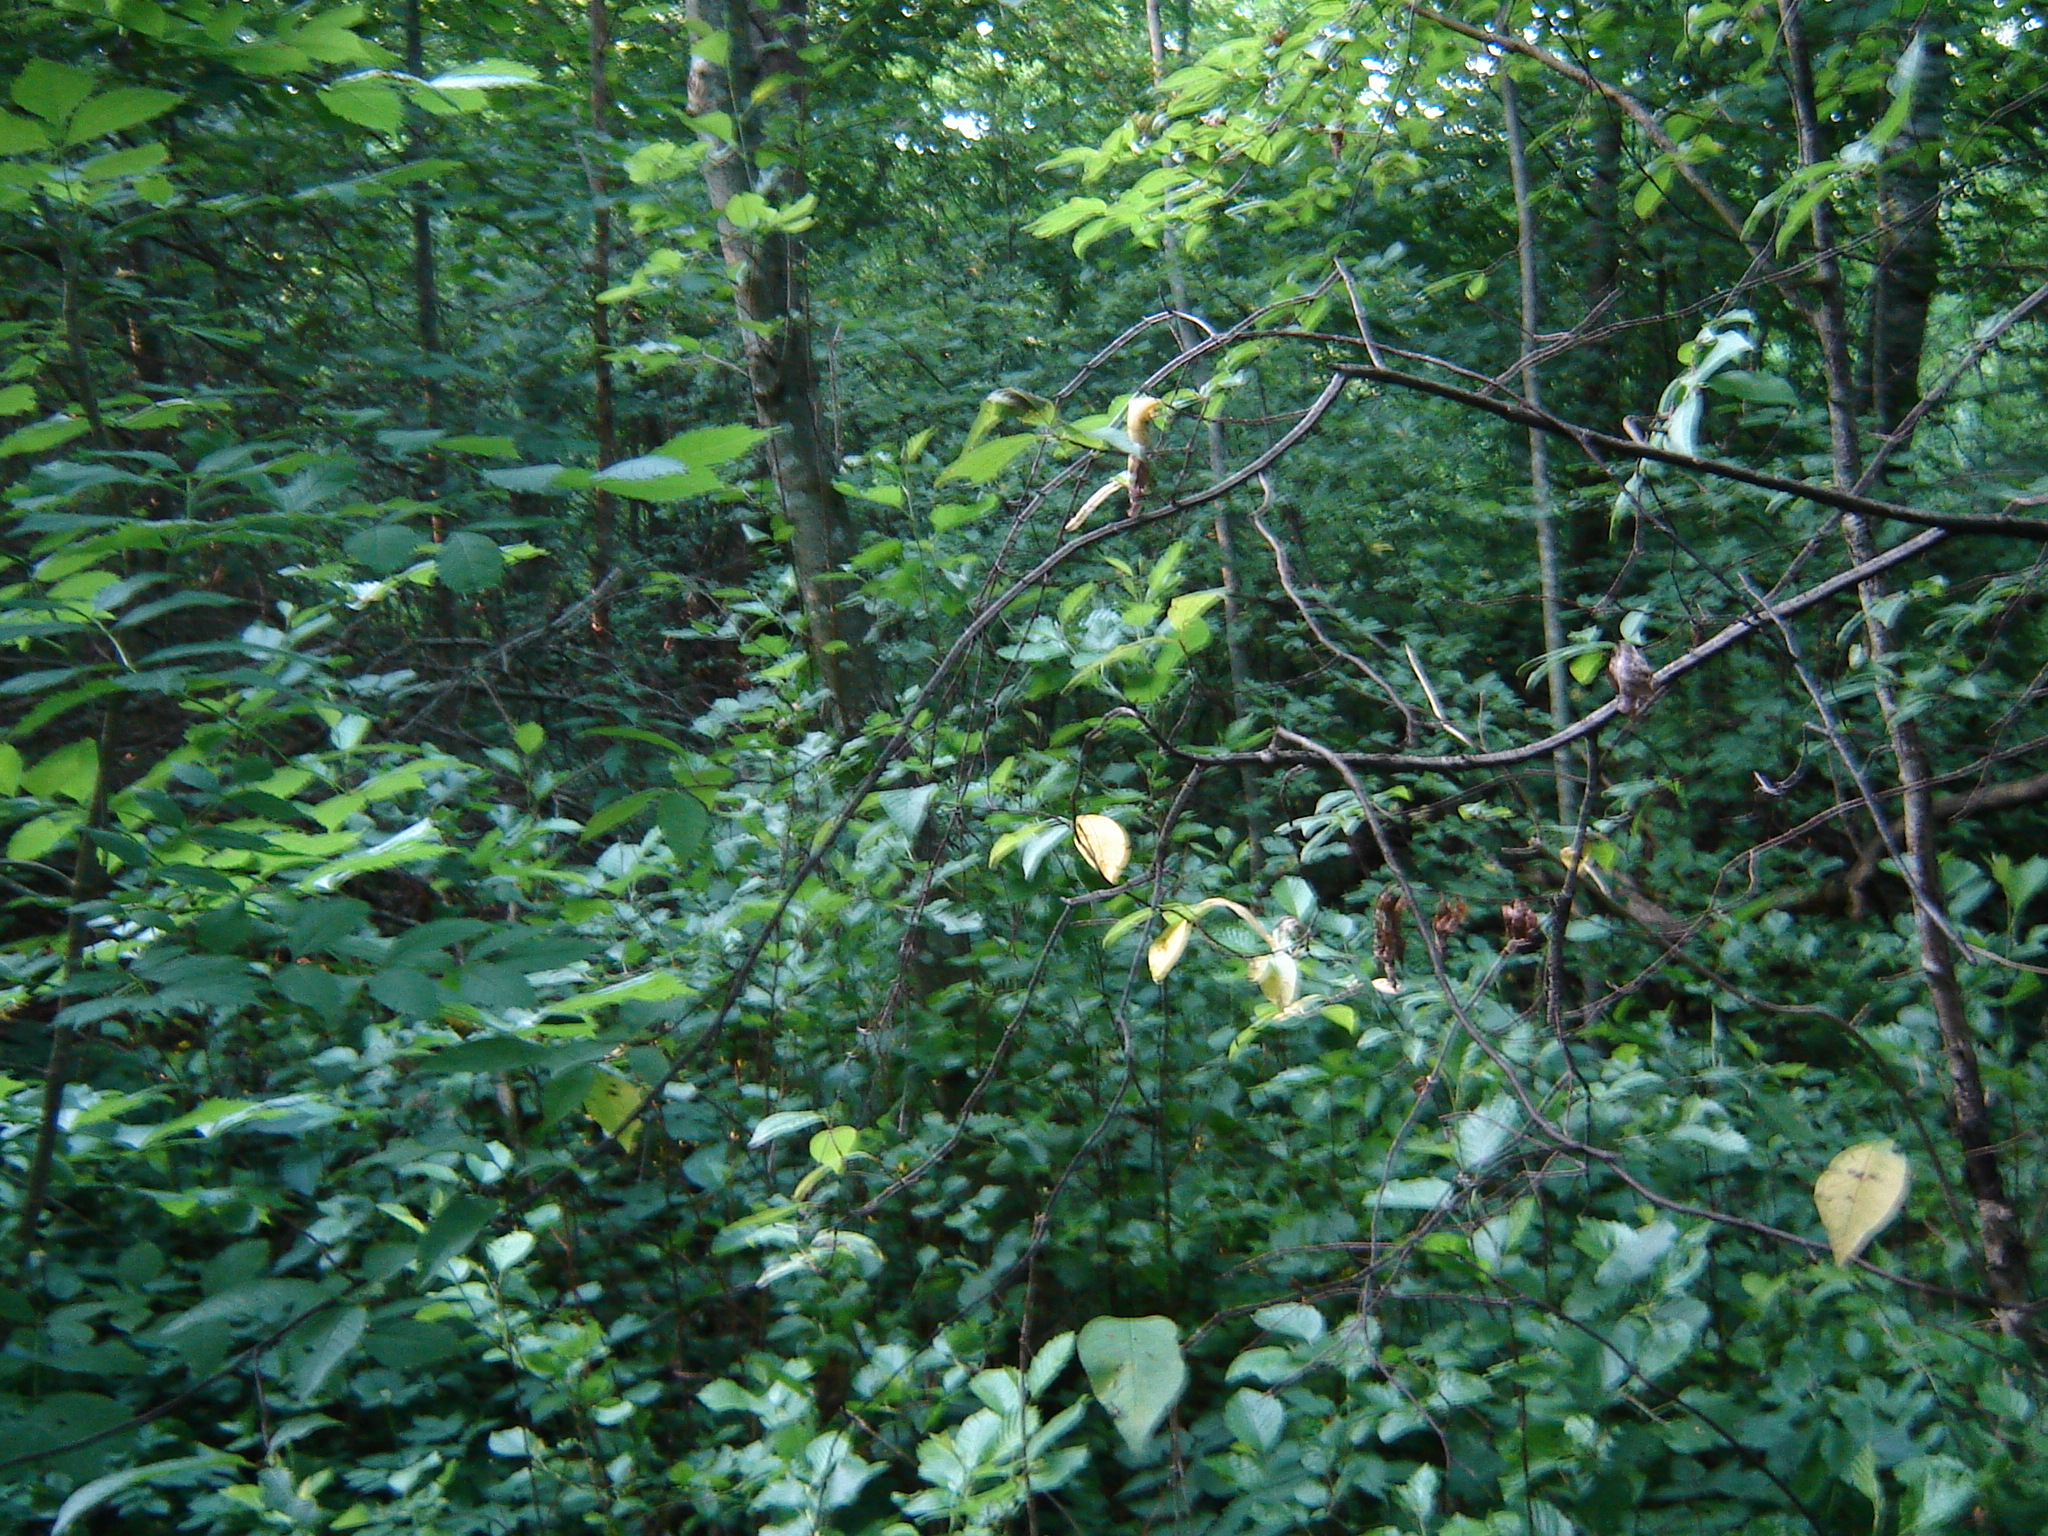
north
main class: Woodland
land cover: Broadleaved woodland
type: non-riverine alder, birch or aspen forest
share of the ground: > 75 %
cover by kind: broadleaved forest trees 100 %
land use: Forestry
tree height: > 5 m
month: July
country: LT
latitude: 55.3999
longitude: 25.5211
